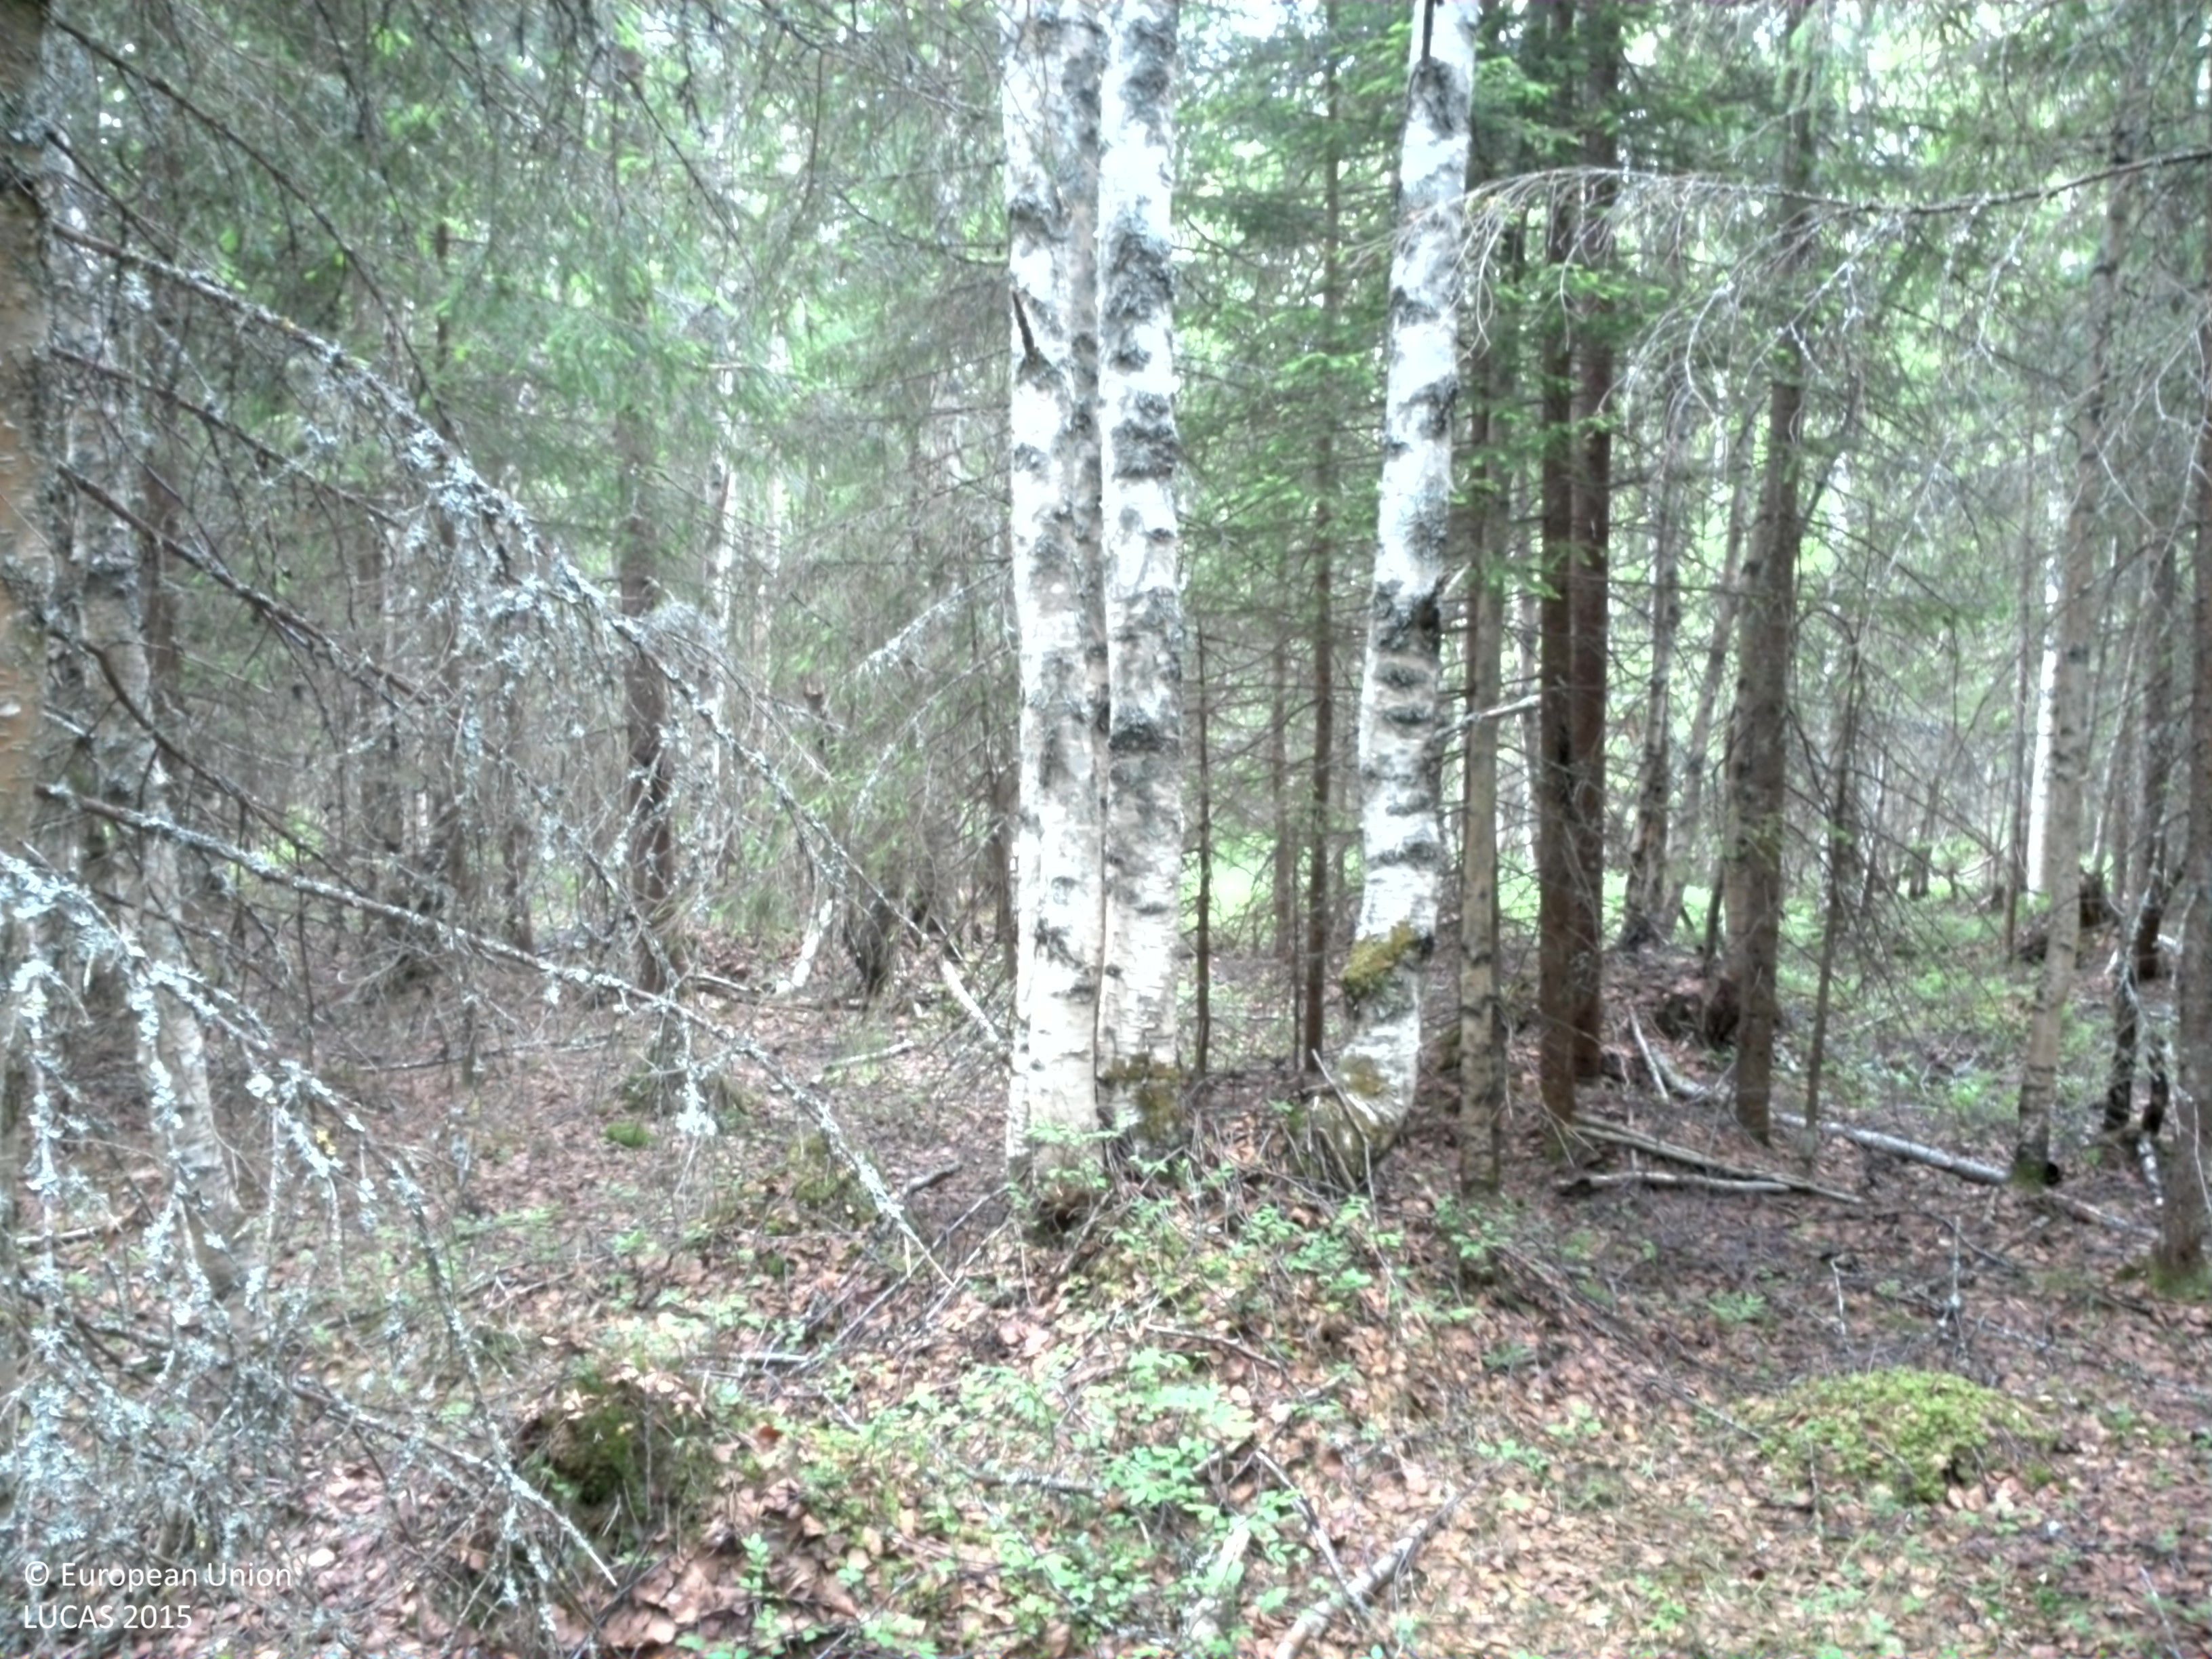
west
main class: Woodland
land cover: Other mixed woodland
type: boreal forest
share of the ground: > 75 %
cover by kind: coniferous forest trees 55 %, broadleaved forest trees 30 %, shrubs 15 %
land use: Forestry
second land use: Amenities, museums, leisure
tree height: > 5 m
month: July
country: SE
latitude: 64.4361
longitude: 20.7174
